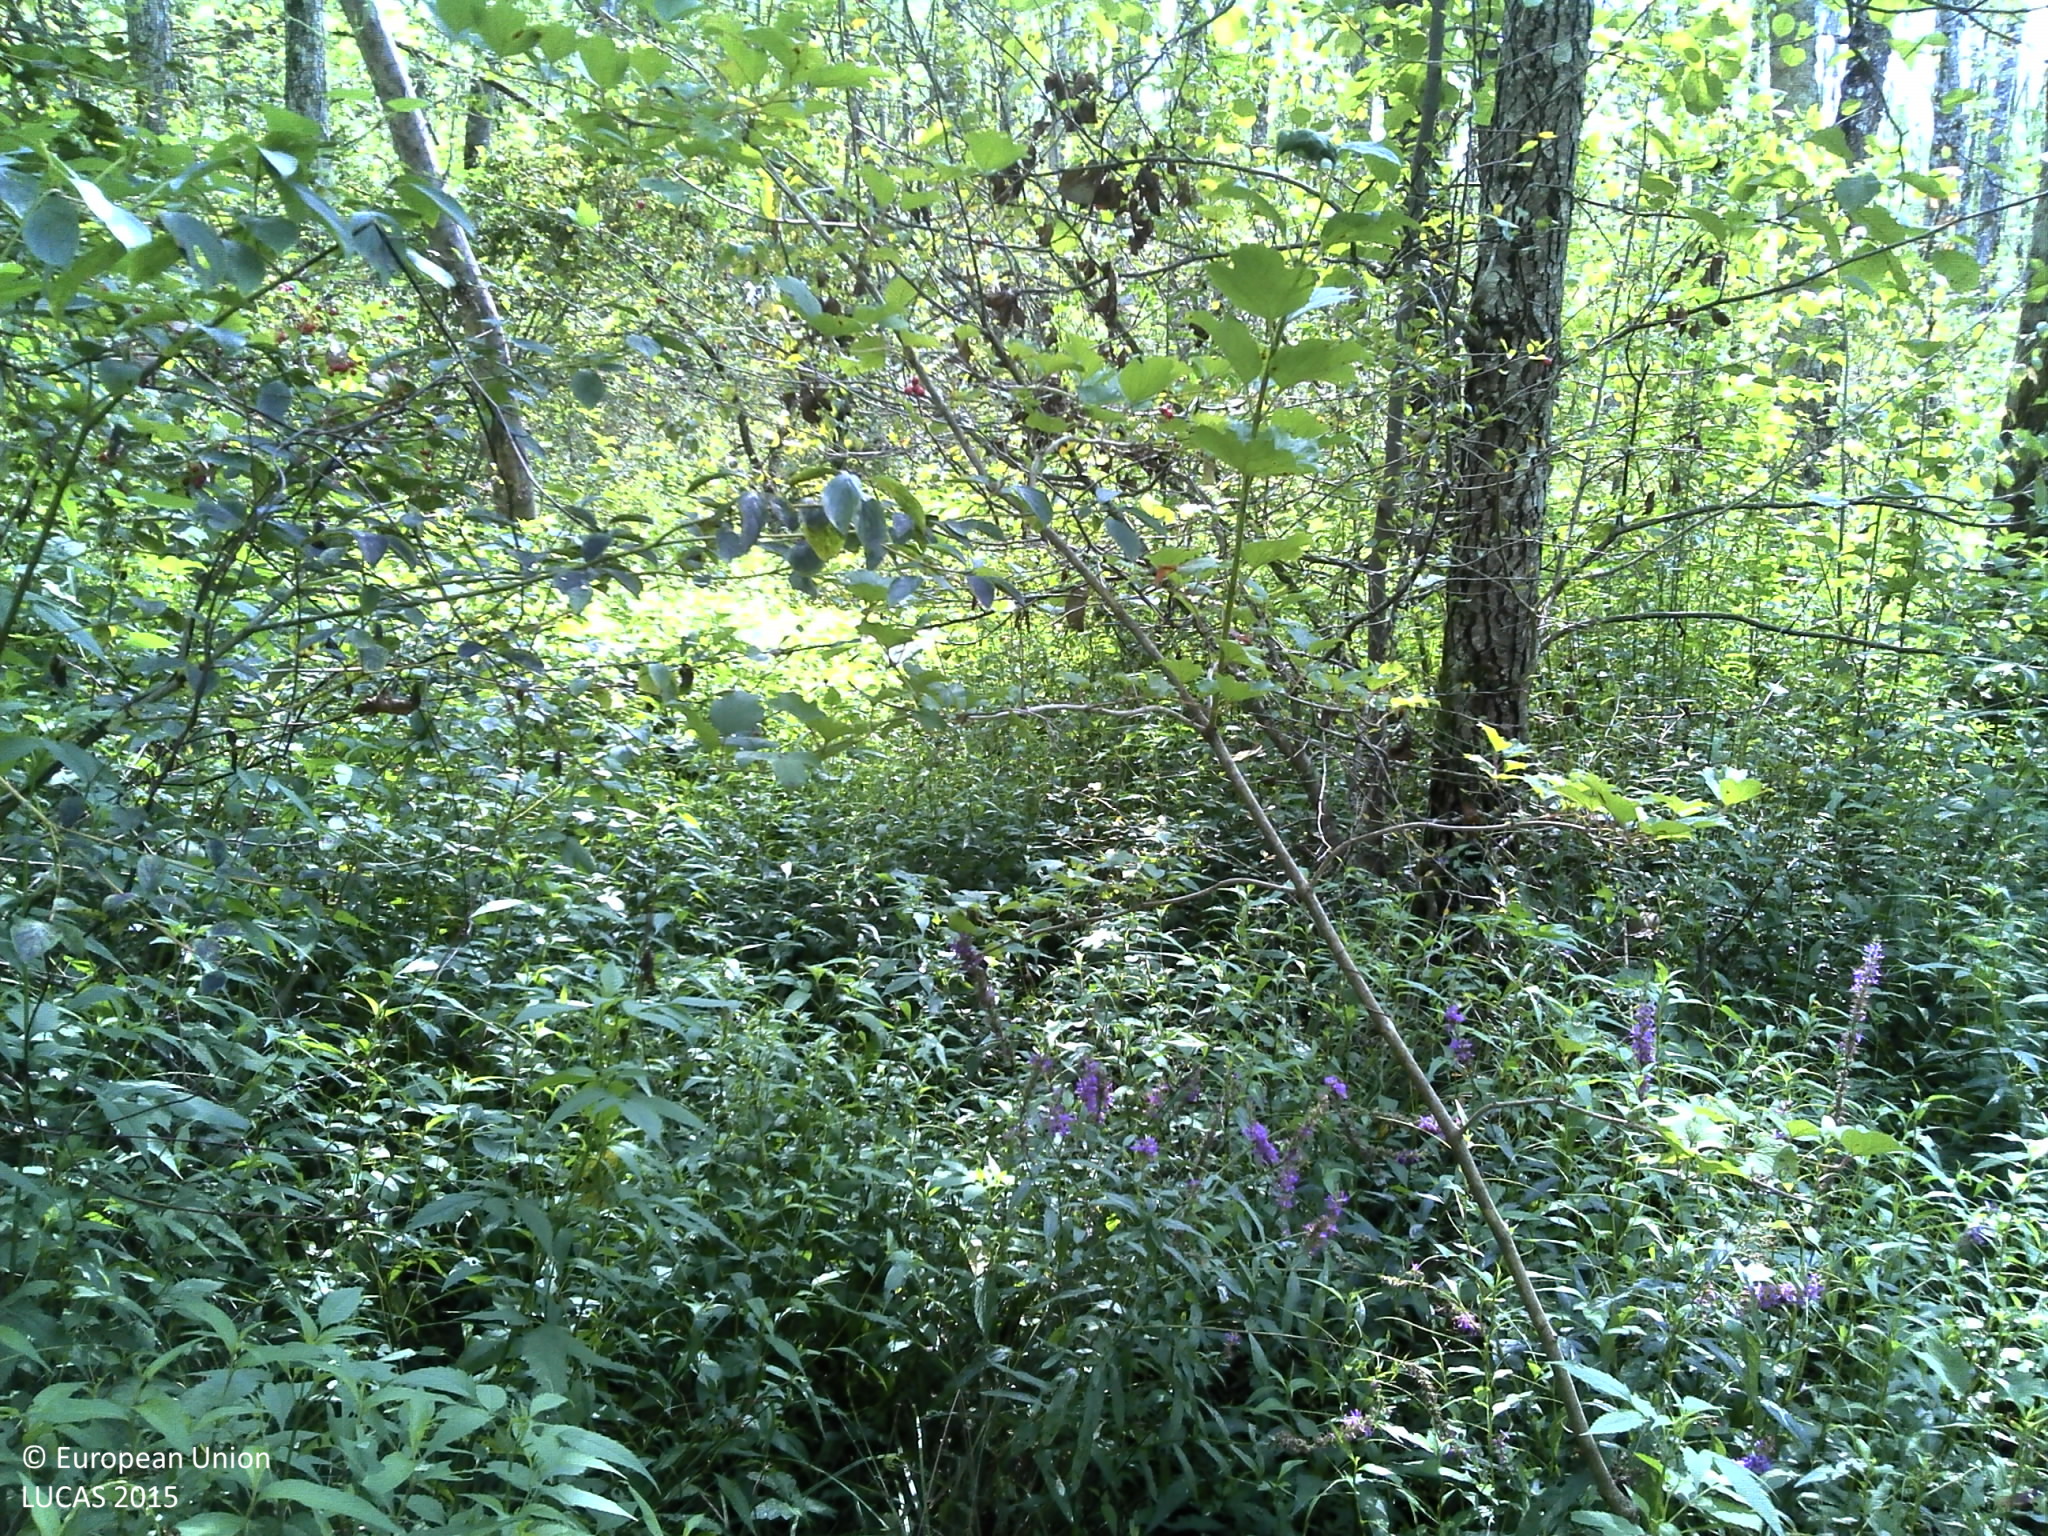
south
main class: Woodland
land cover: Broadleaved woodland
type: mesophytic deciduous forest
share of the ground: > 75 %
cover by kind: broadleaved forest trees 100 %
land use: Forestry
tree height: > 5 m
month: August
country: HR
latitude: 45.5838
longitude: 15.7258
